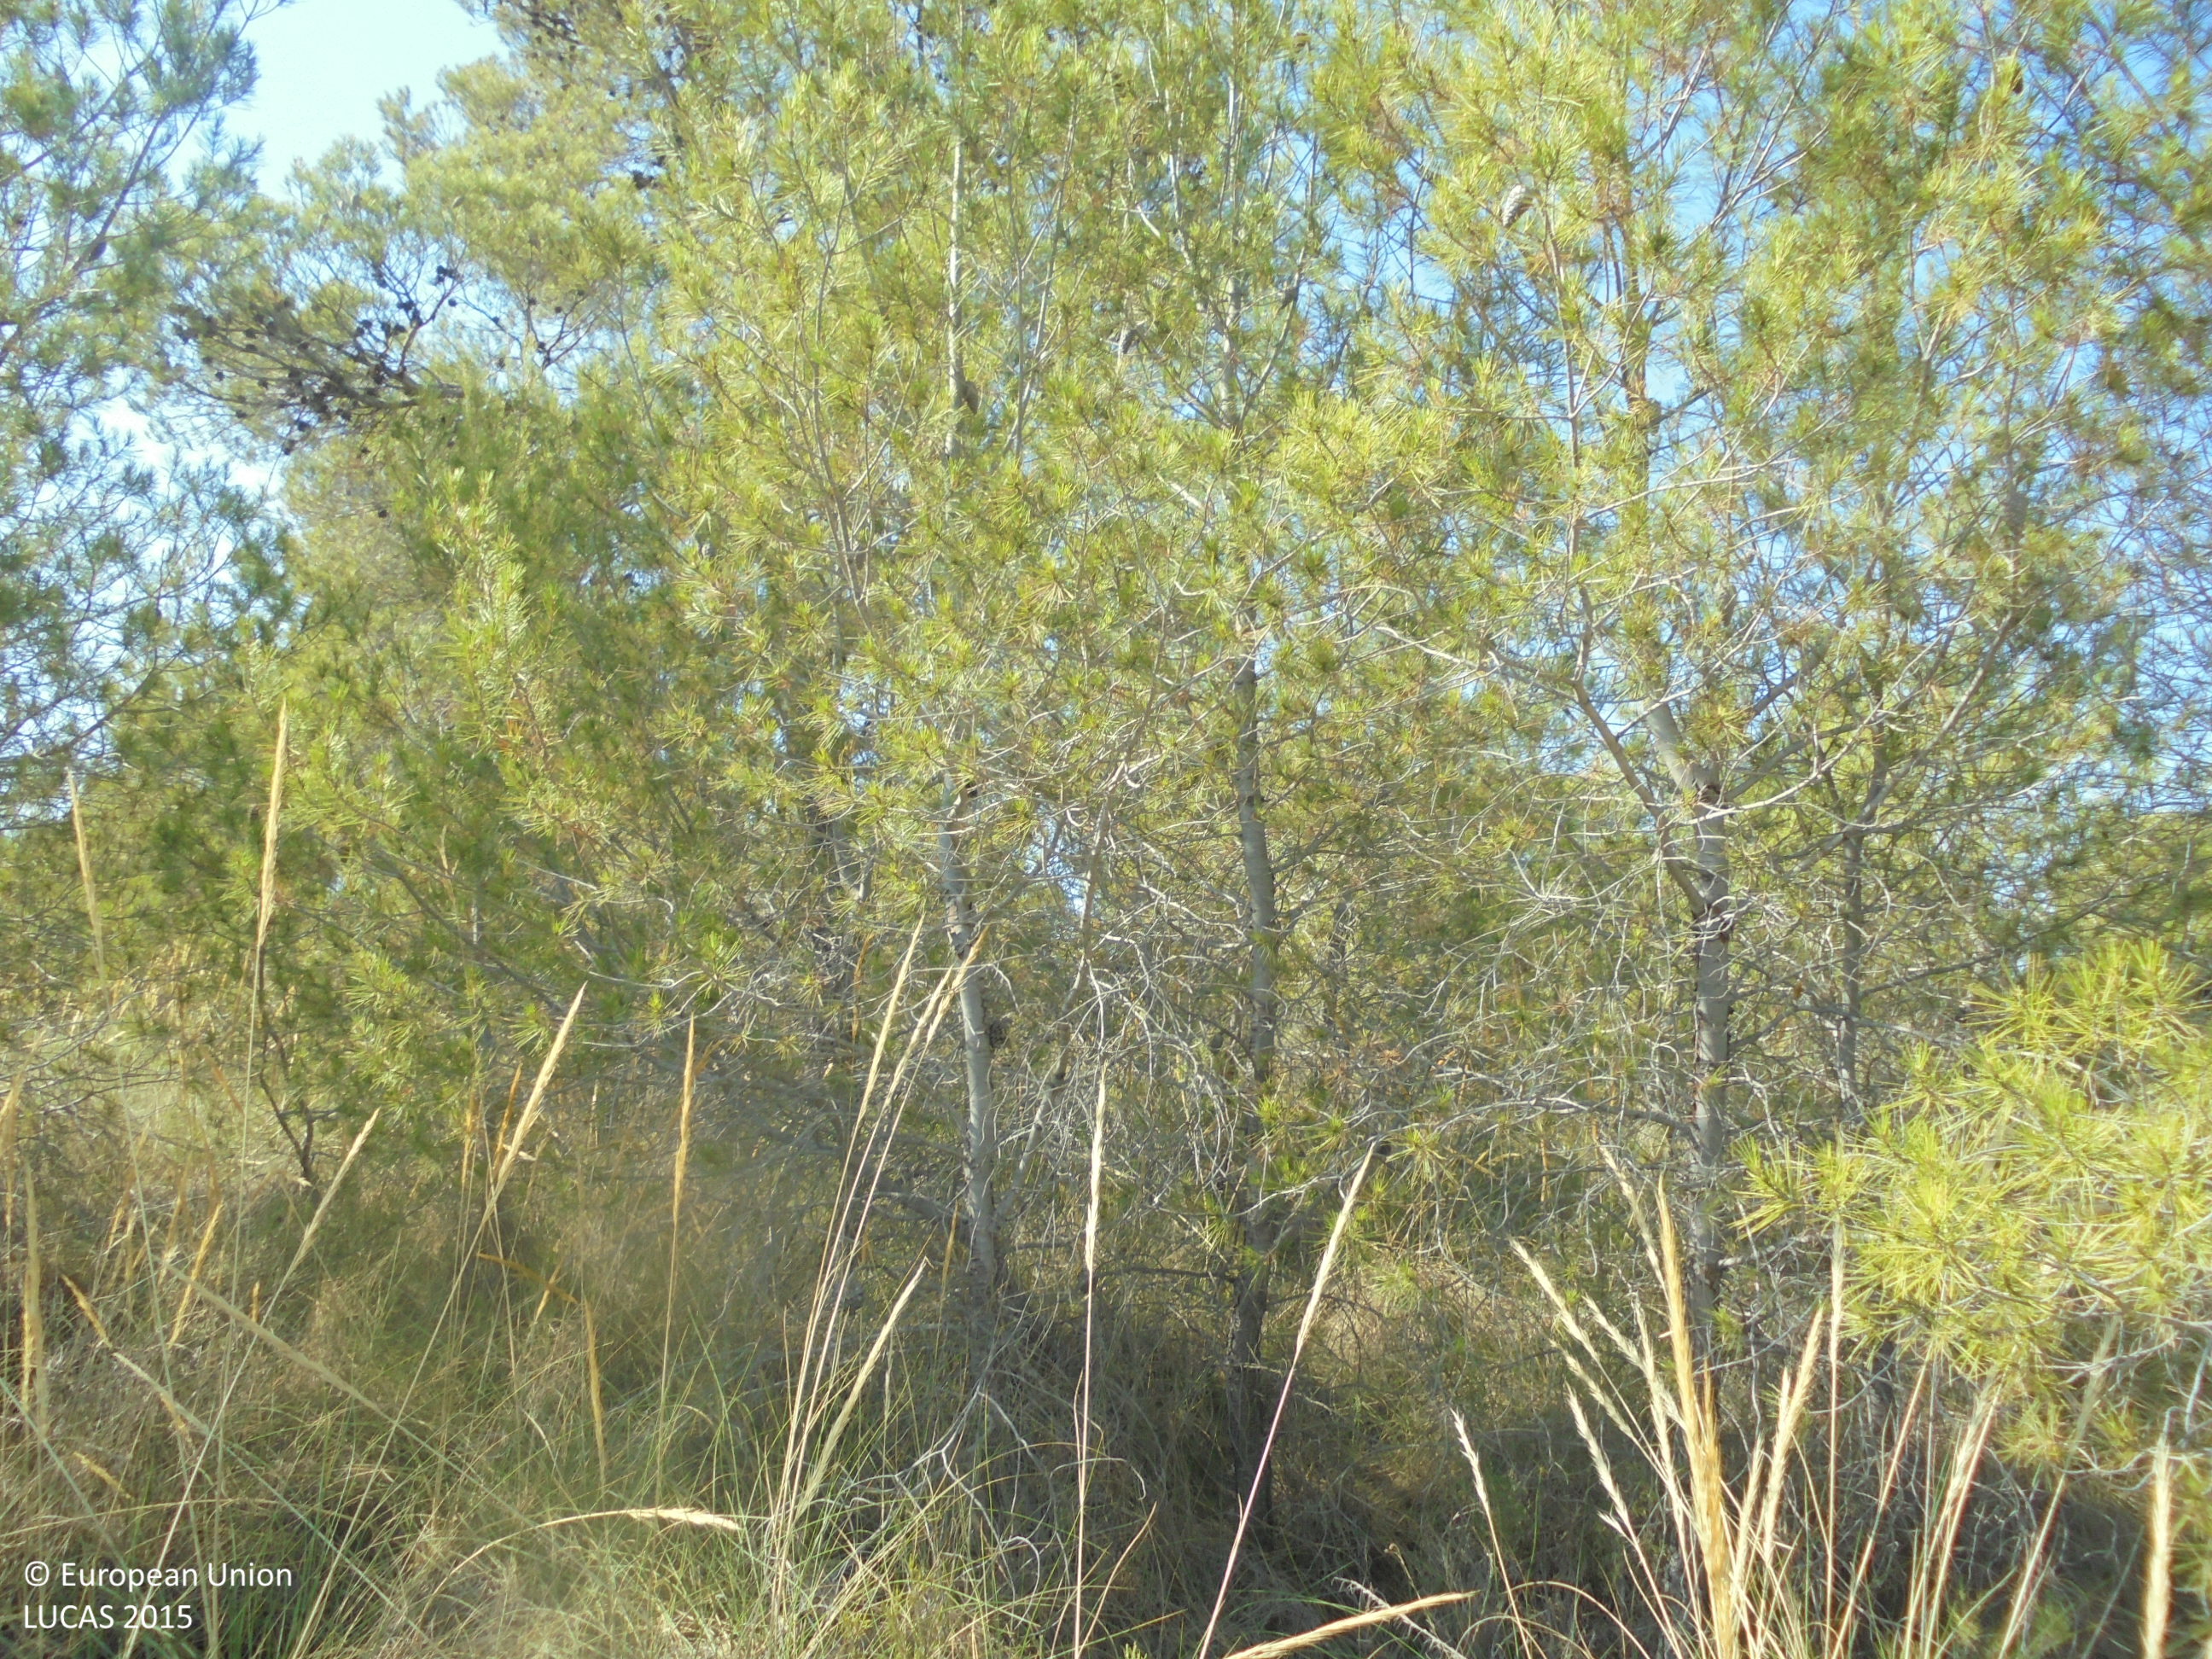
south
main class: Woodland
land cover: Pine dominated coniferous woodland
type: coniferous forest of the mediterranean region
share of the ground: 25 - 50 %
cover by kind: coniferous forest trees 45 %, shrubs 35 %, unconsolidated bare surface 20 %
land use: Semi-natural and natural areas not in use
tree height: > 5 m
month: July
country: ES
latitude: 38.5348
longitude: -1.4526
